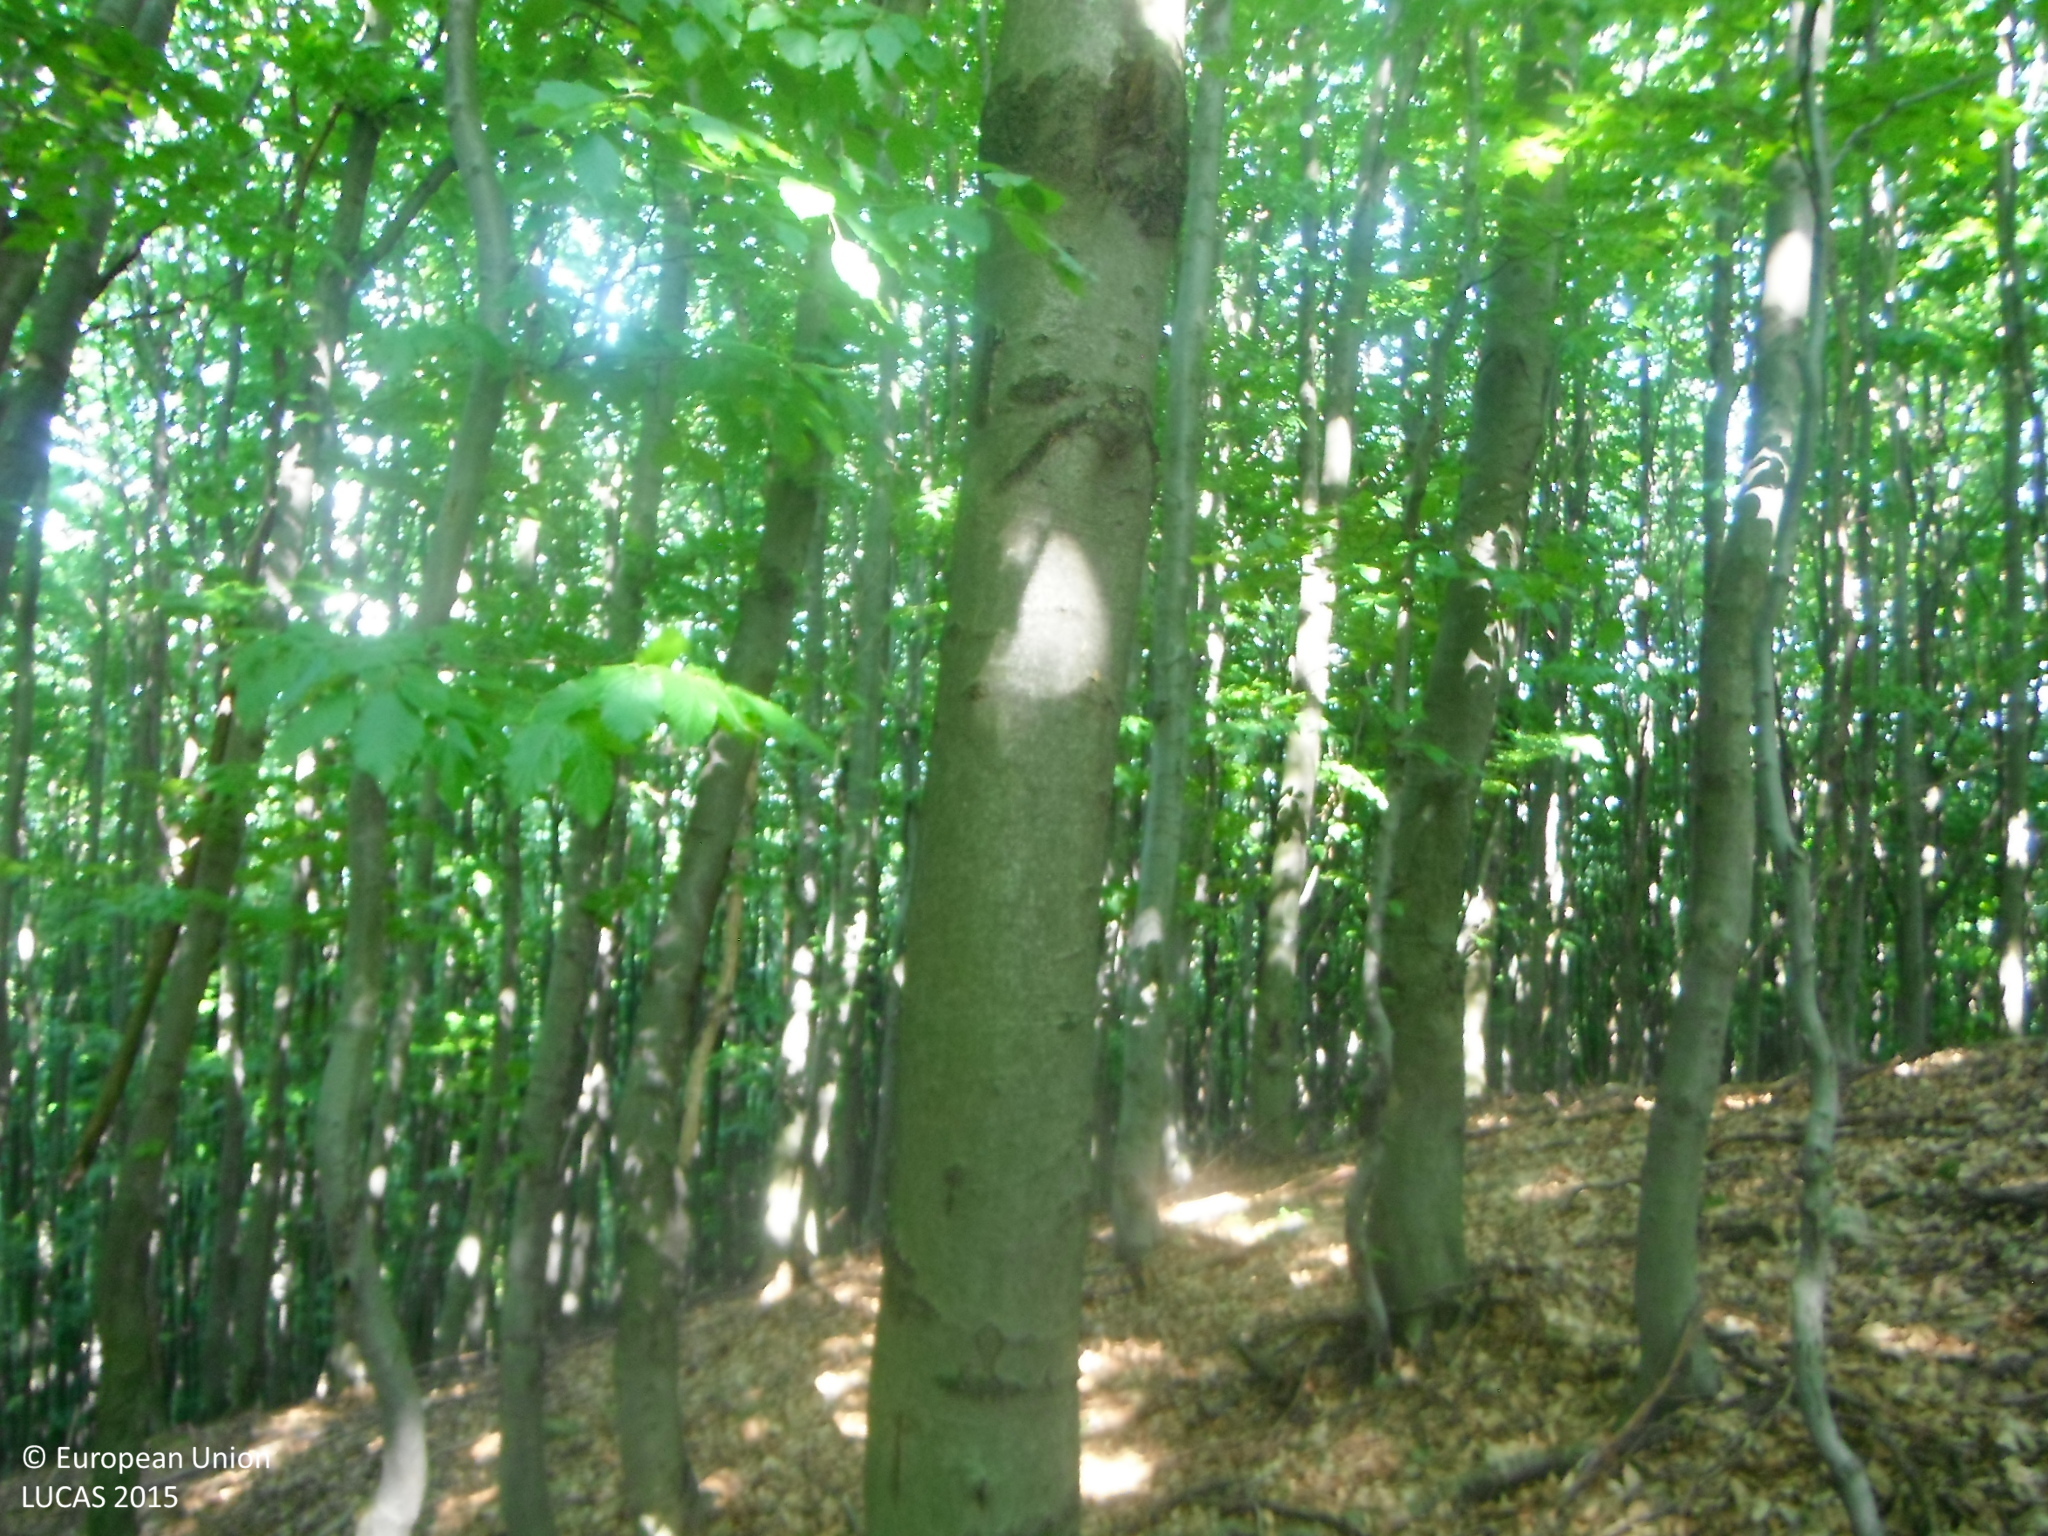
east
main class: Woodland
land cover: Broadleaved woodland
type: beech forest
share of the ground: > 75 %
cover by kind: broadleaved forest trees 100 %
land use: Forestry
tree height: > 5 m
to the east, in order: Broadleaved woodland; Tracks; Broadleaved woodland
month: June
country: SK
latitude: 48.4173
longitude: 17.2650
